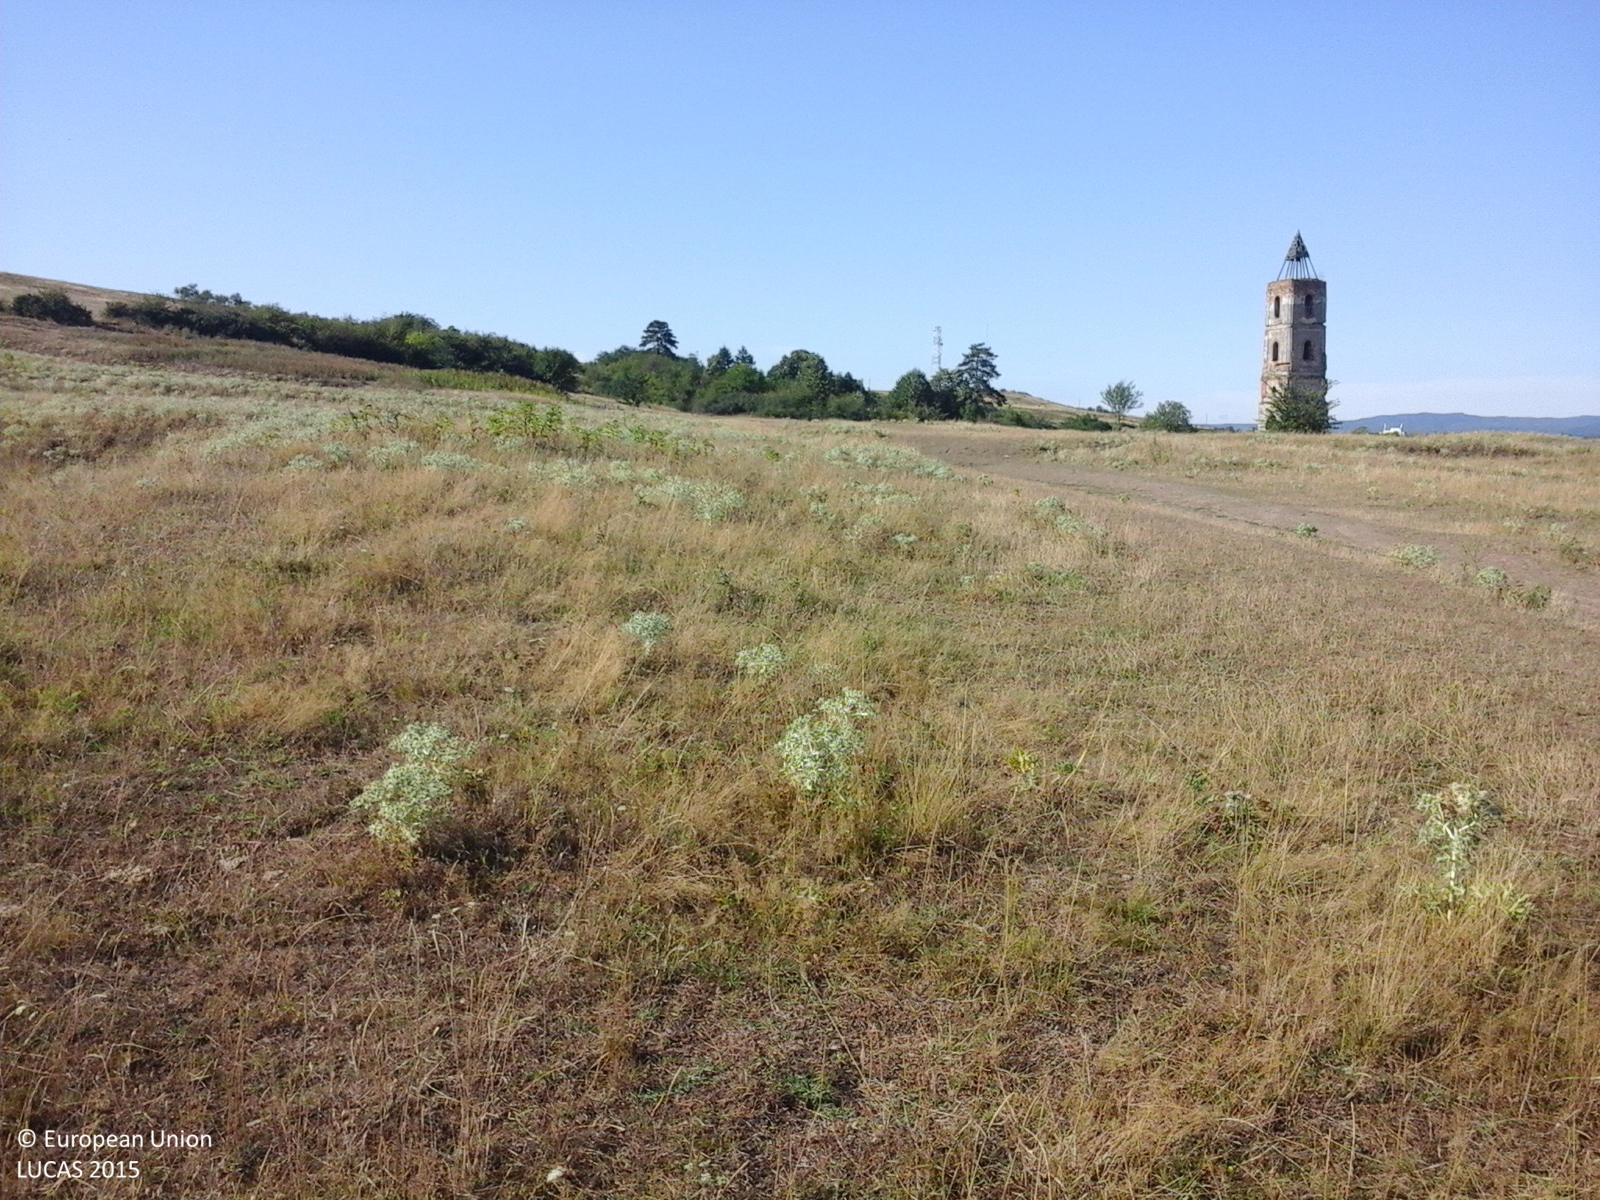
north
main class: Grassland
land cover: Spontaneously vegetated surfaces
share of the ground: > 75 %
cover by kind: herbaceous plants 100 %
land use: Semi-natural and natural areas not in use
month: August
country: RO
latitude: 45.1189
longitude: 21.5863
